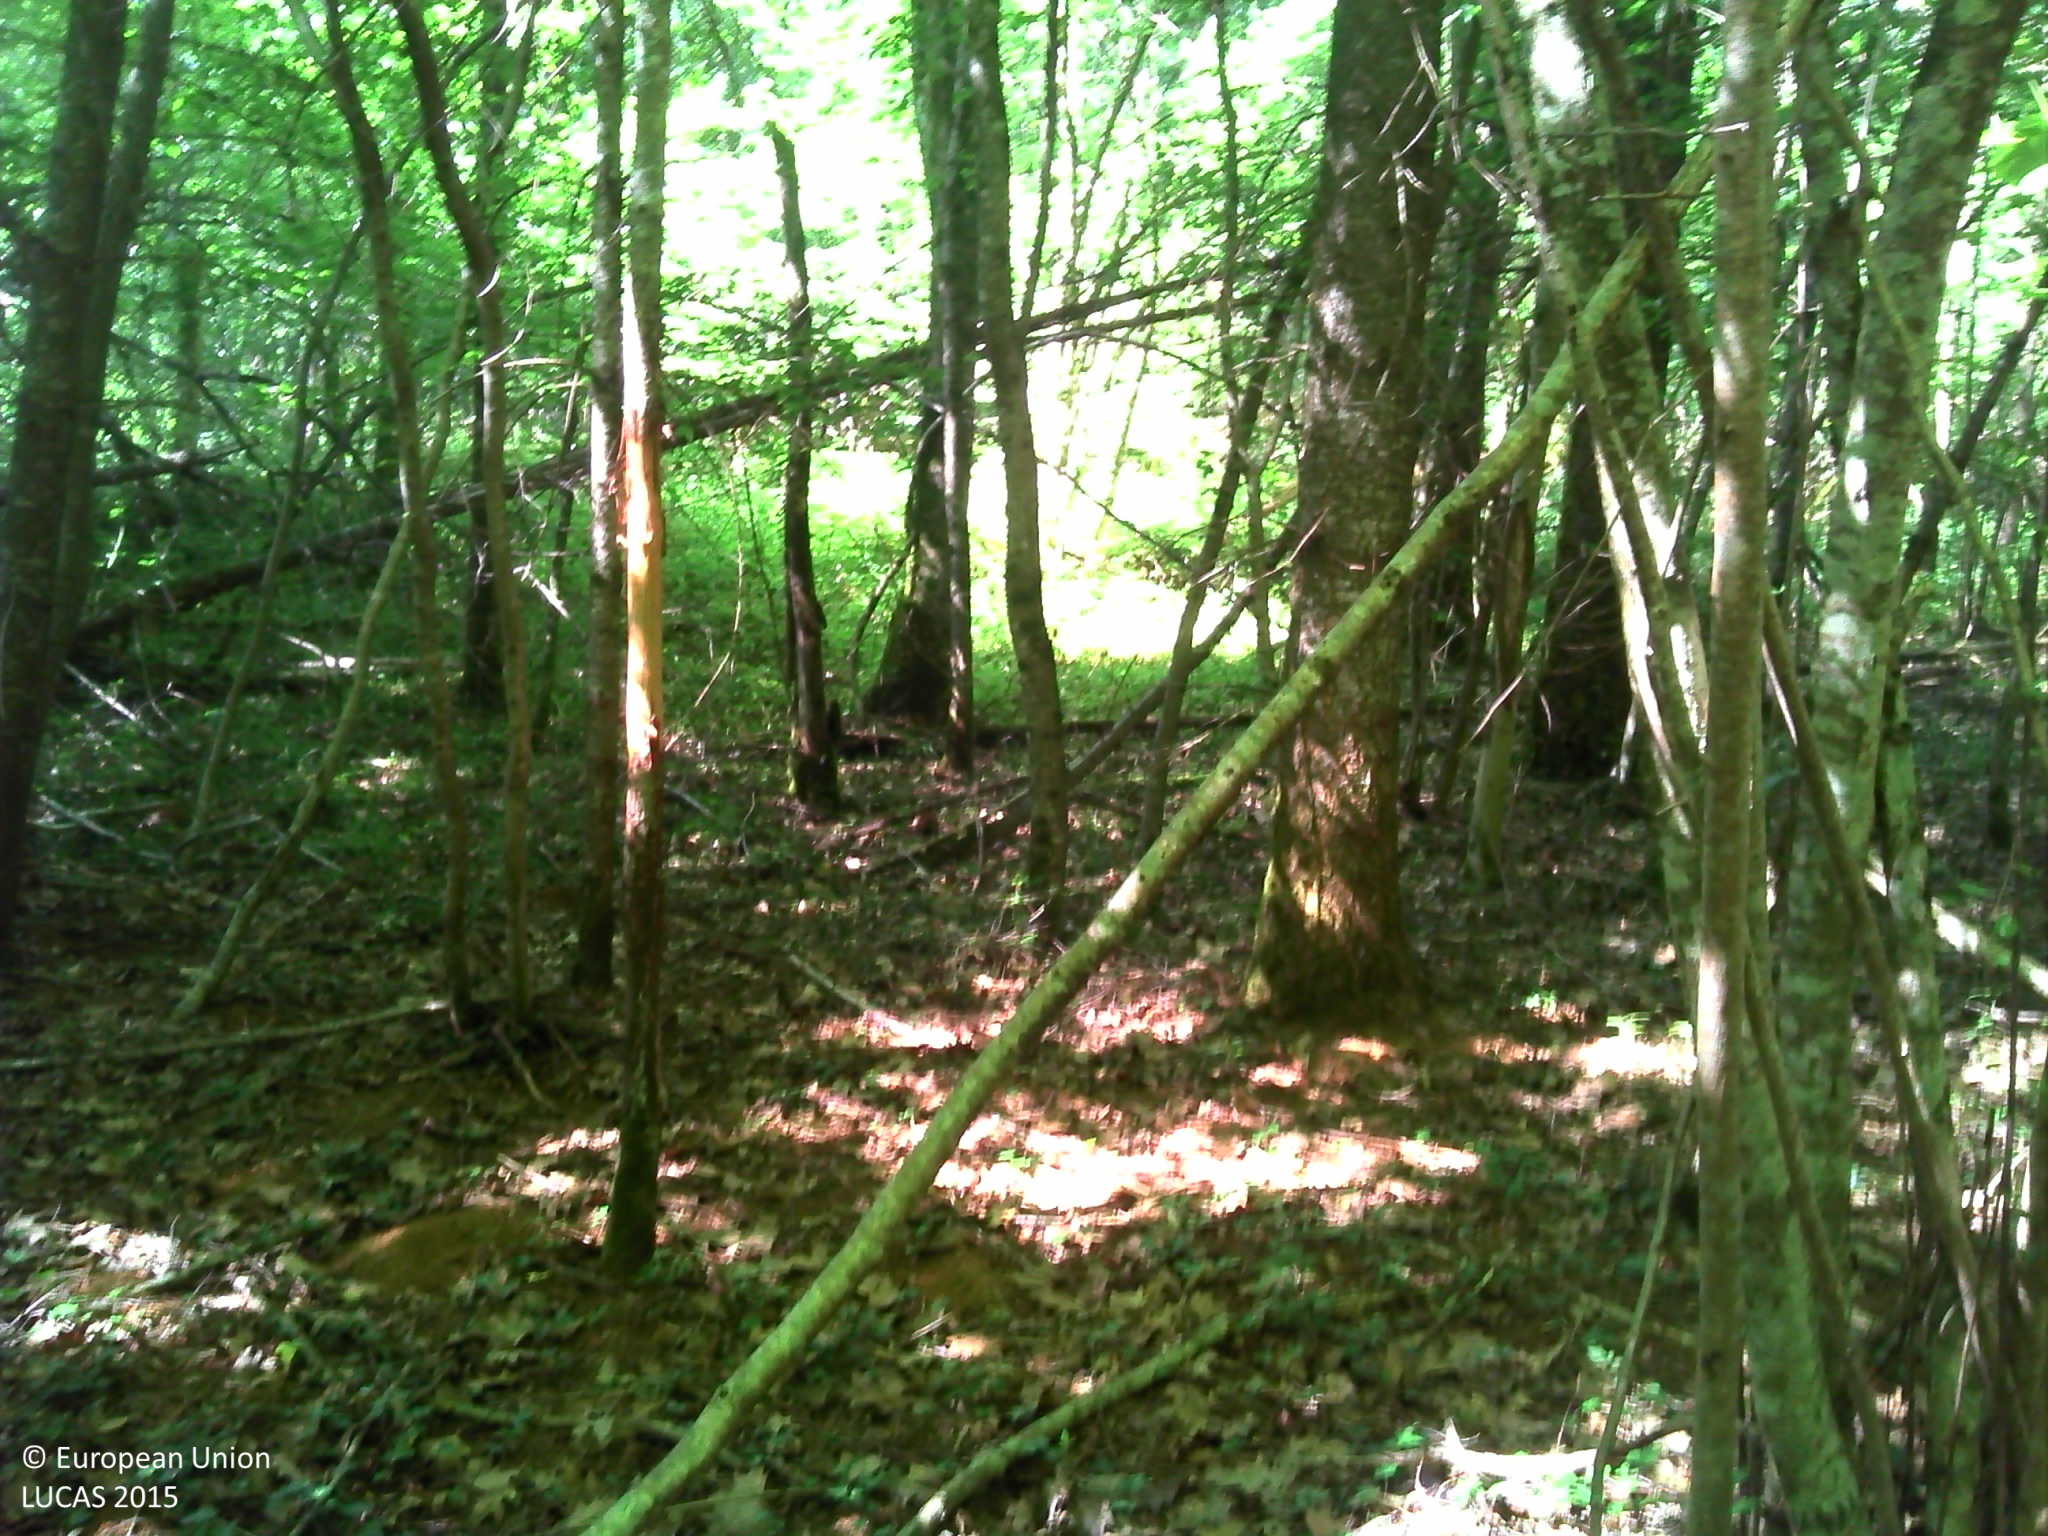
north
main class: Woodland
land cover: Broadleaved woodland
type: beech forest
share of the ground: > 75 %
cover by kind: broadleaved forest trees 90 %, shrubs 5 %, herbaceous plants 5 %
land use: Forestry
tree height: > 5 m
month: June
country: FR
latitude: 47.5073
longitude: 6.1378
